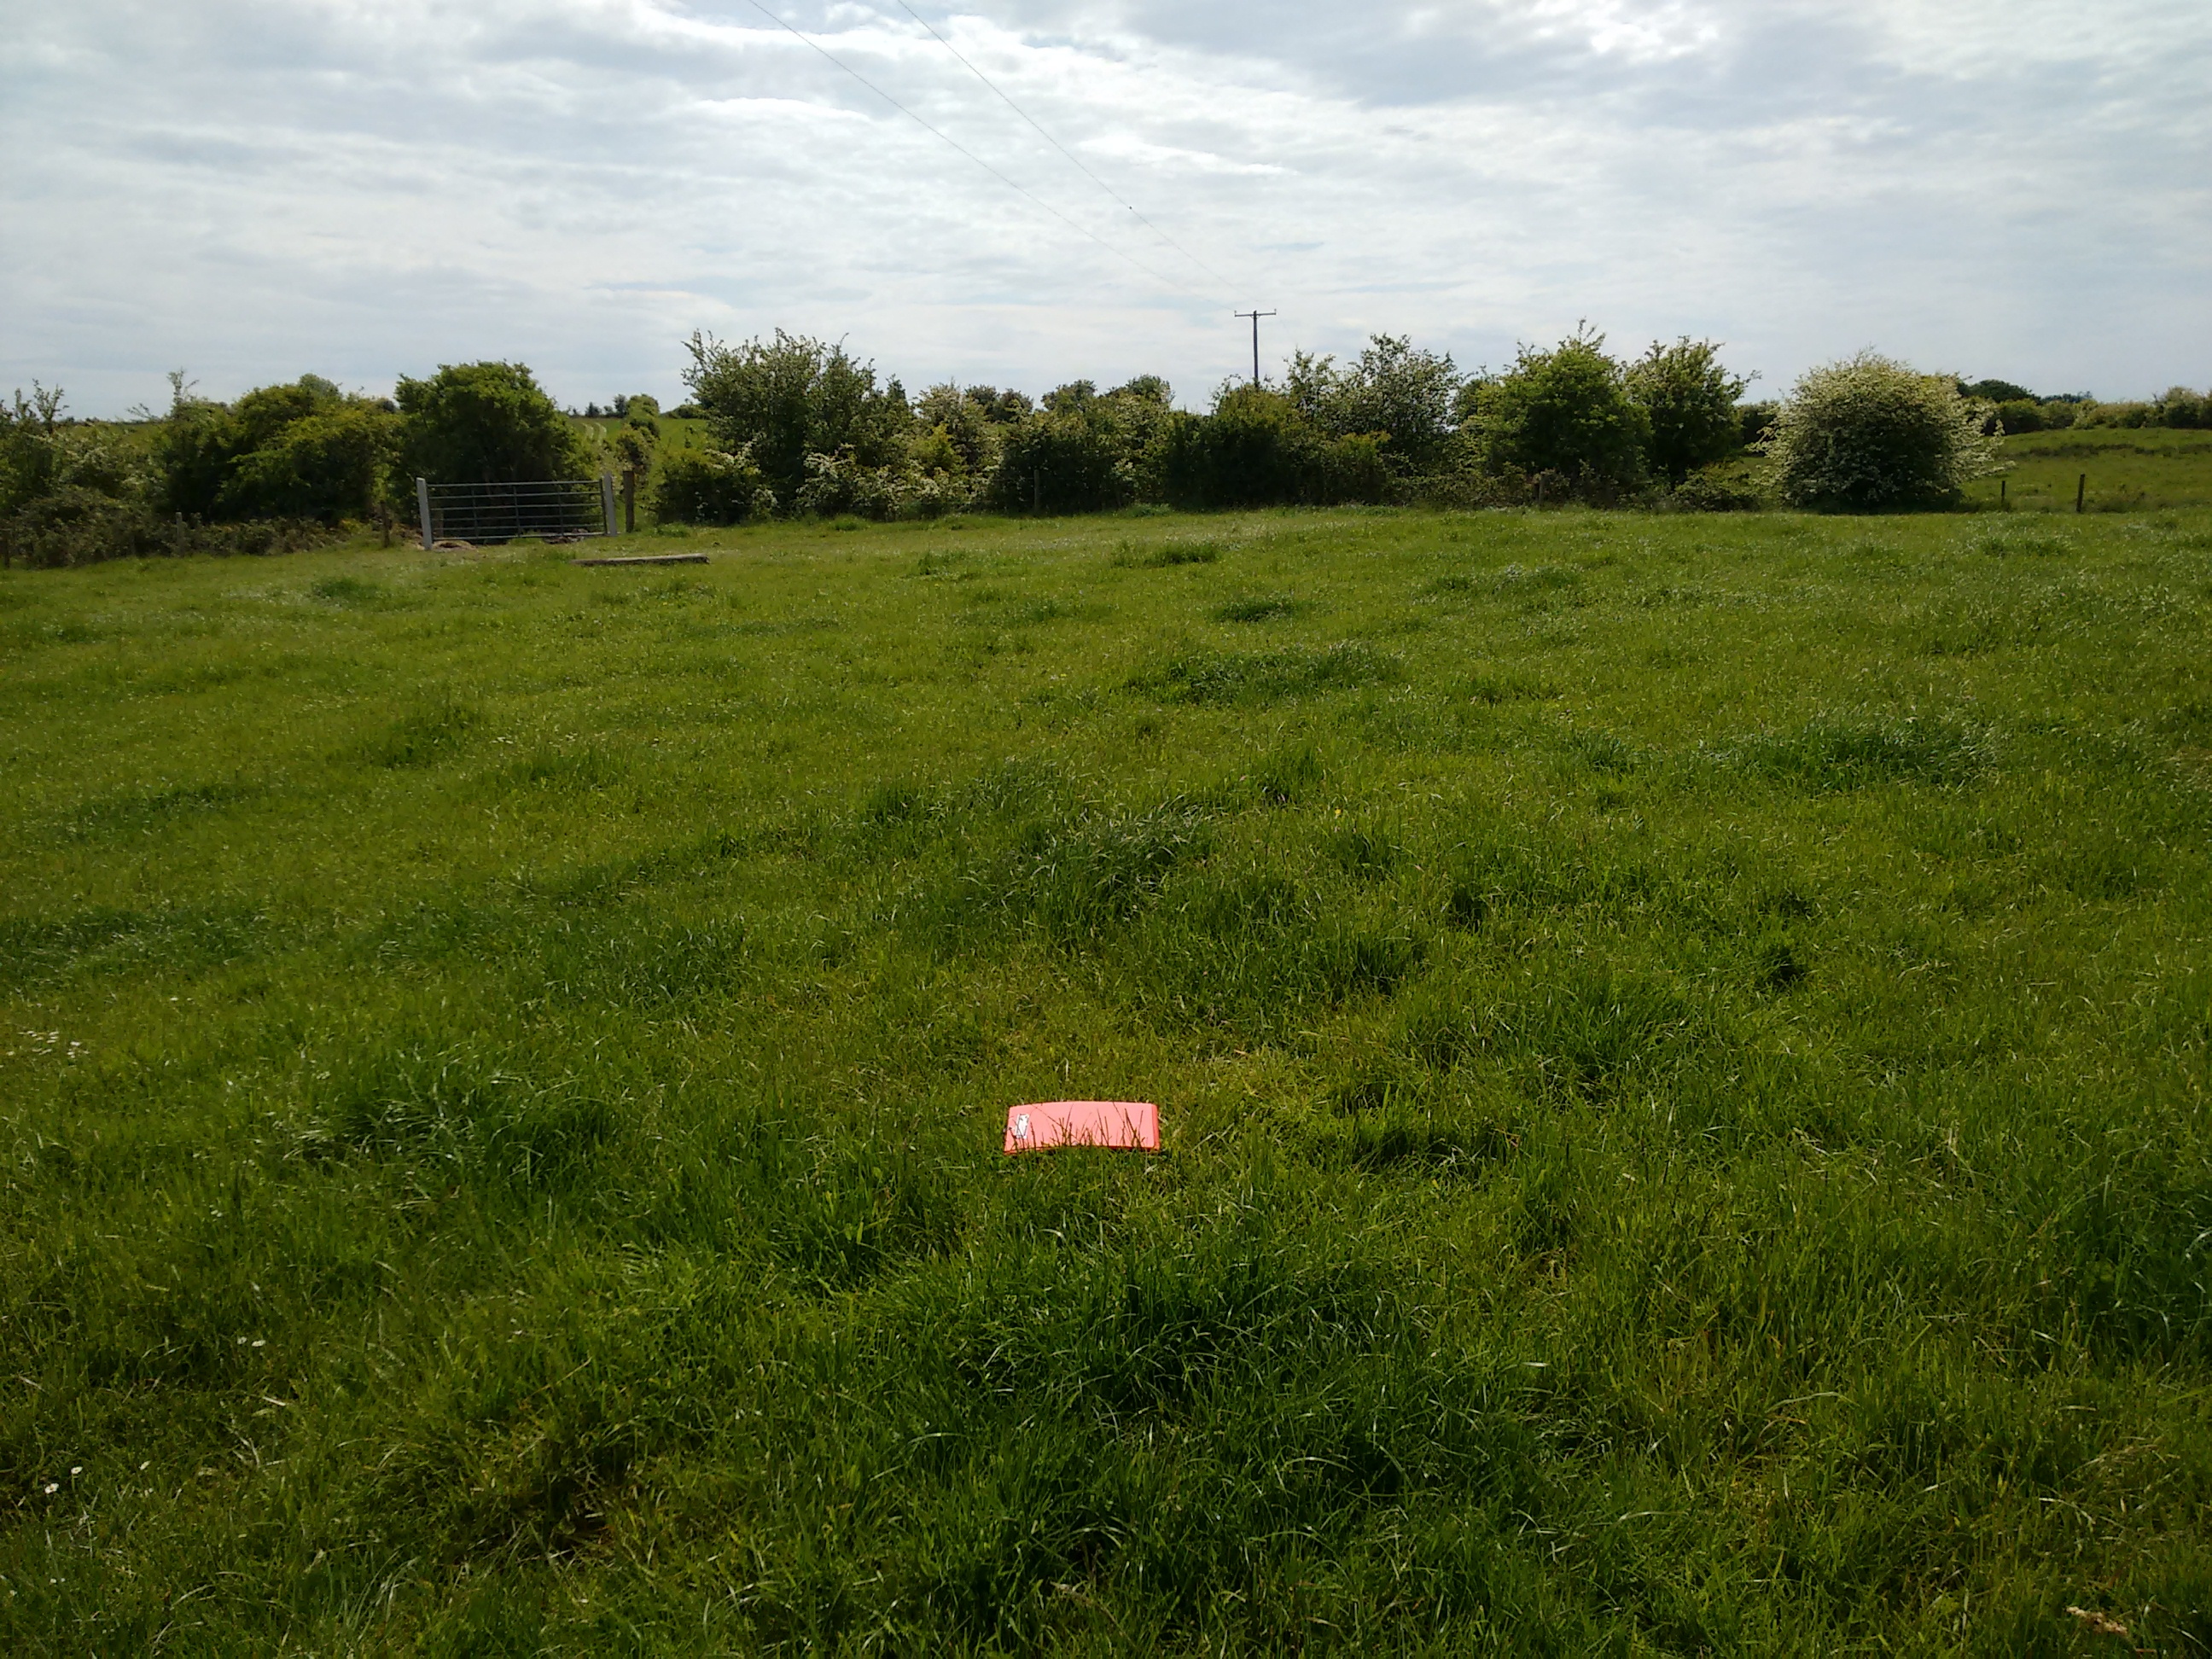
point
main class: Grassland
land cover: Grassland without tree/shrub cover
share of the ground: > 75 %
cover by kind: herbaceous plants 100 %
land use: Agriculture (excluding fallow land and kitchen gardens)
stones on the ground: < 10 %
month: June
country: IE
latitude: 53.4932
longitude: -8.7266
